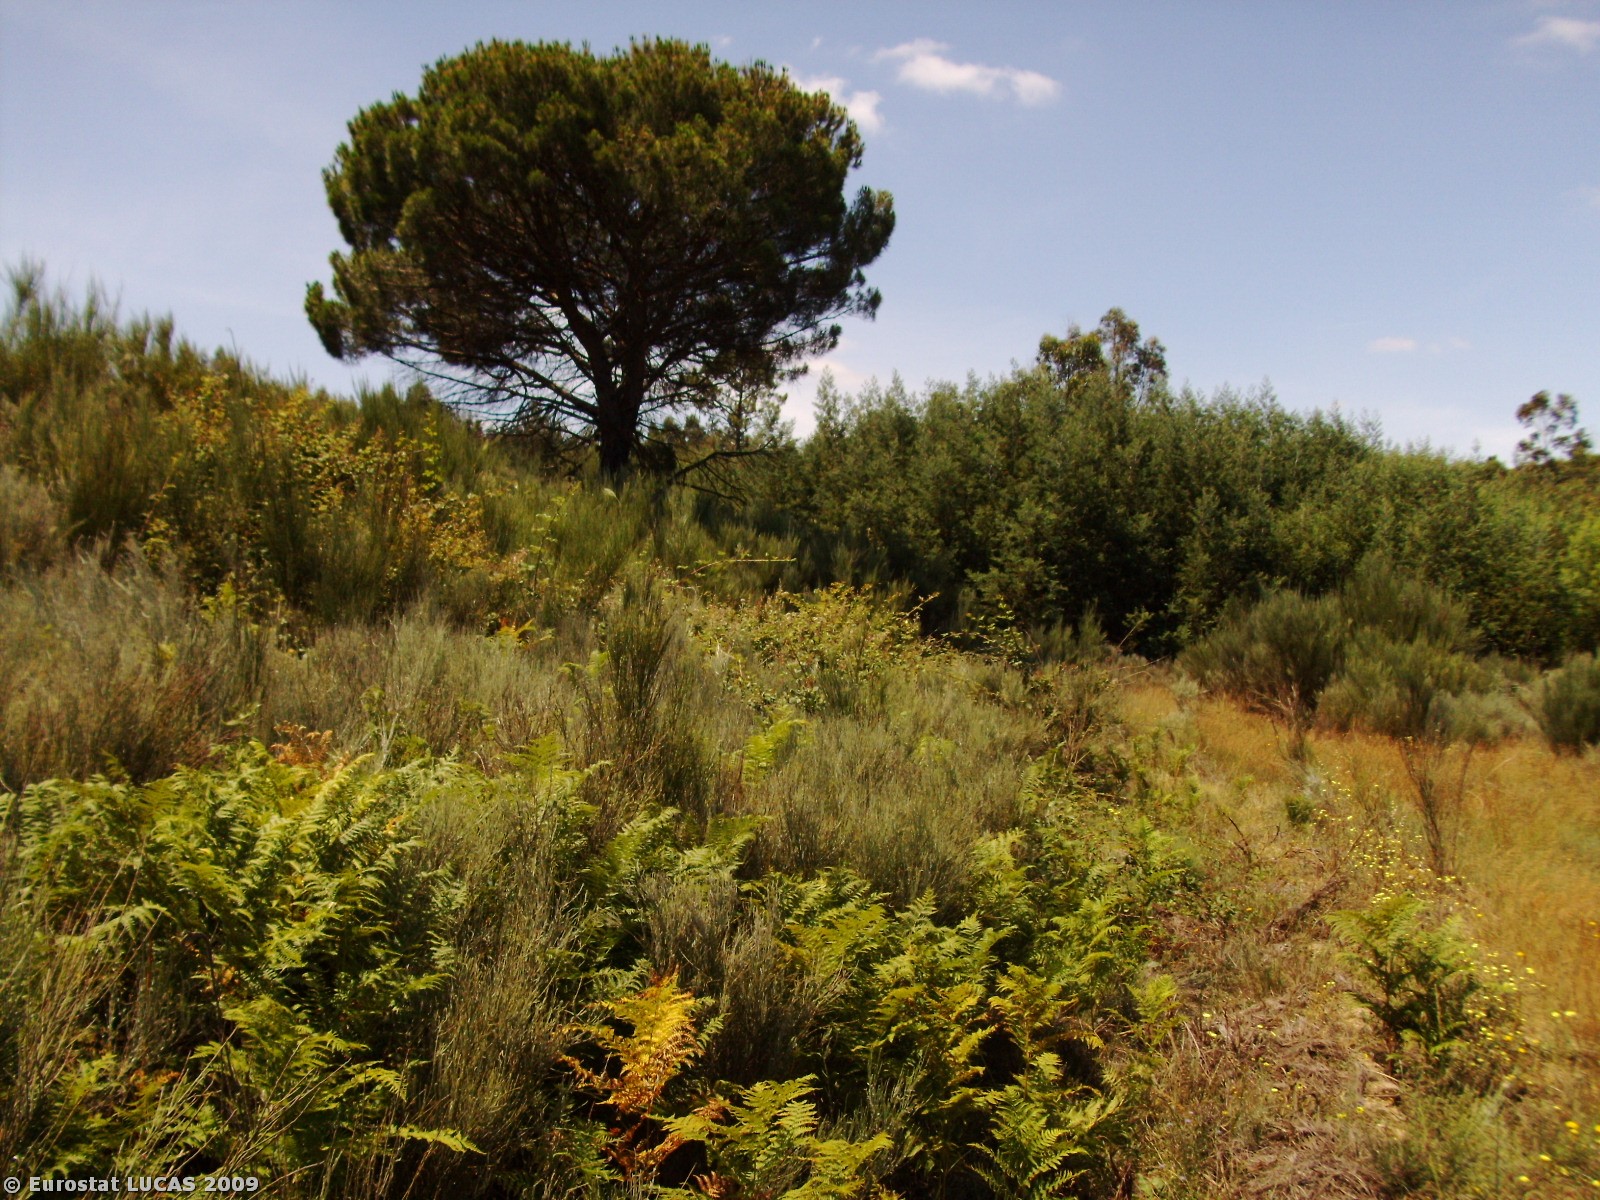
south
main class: Shrubland
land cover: Shrubland without tree cover
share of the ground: > 75 %
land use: Unused
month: July
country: PT
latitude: 40.5272
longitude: -7.5964
